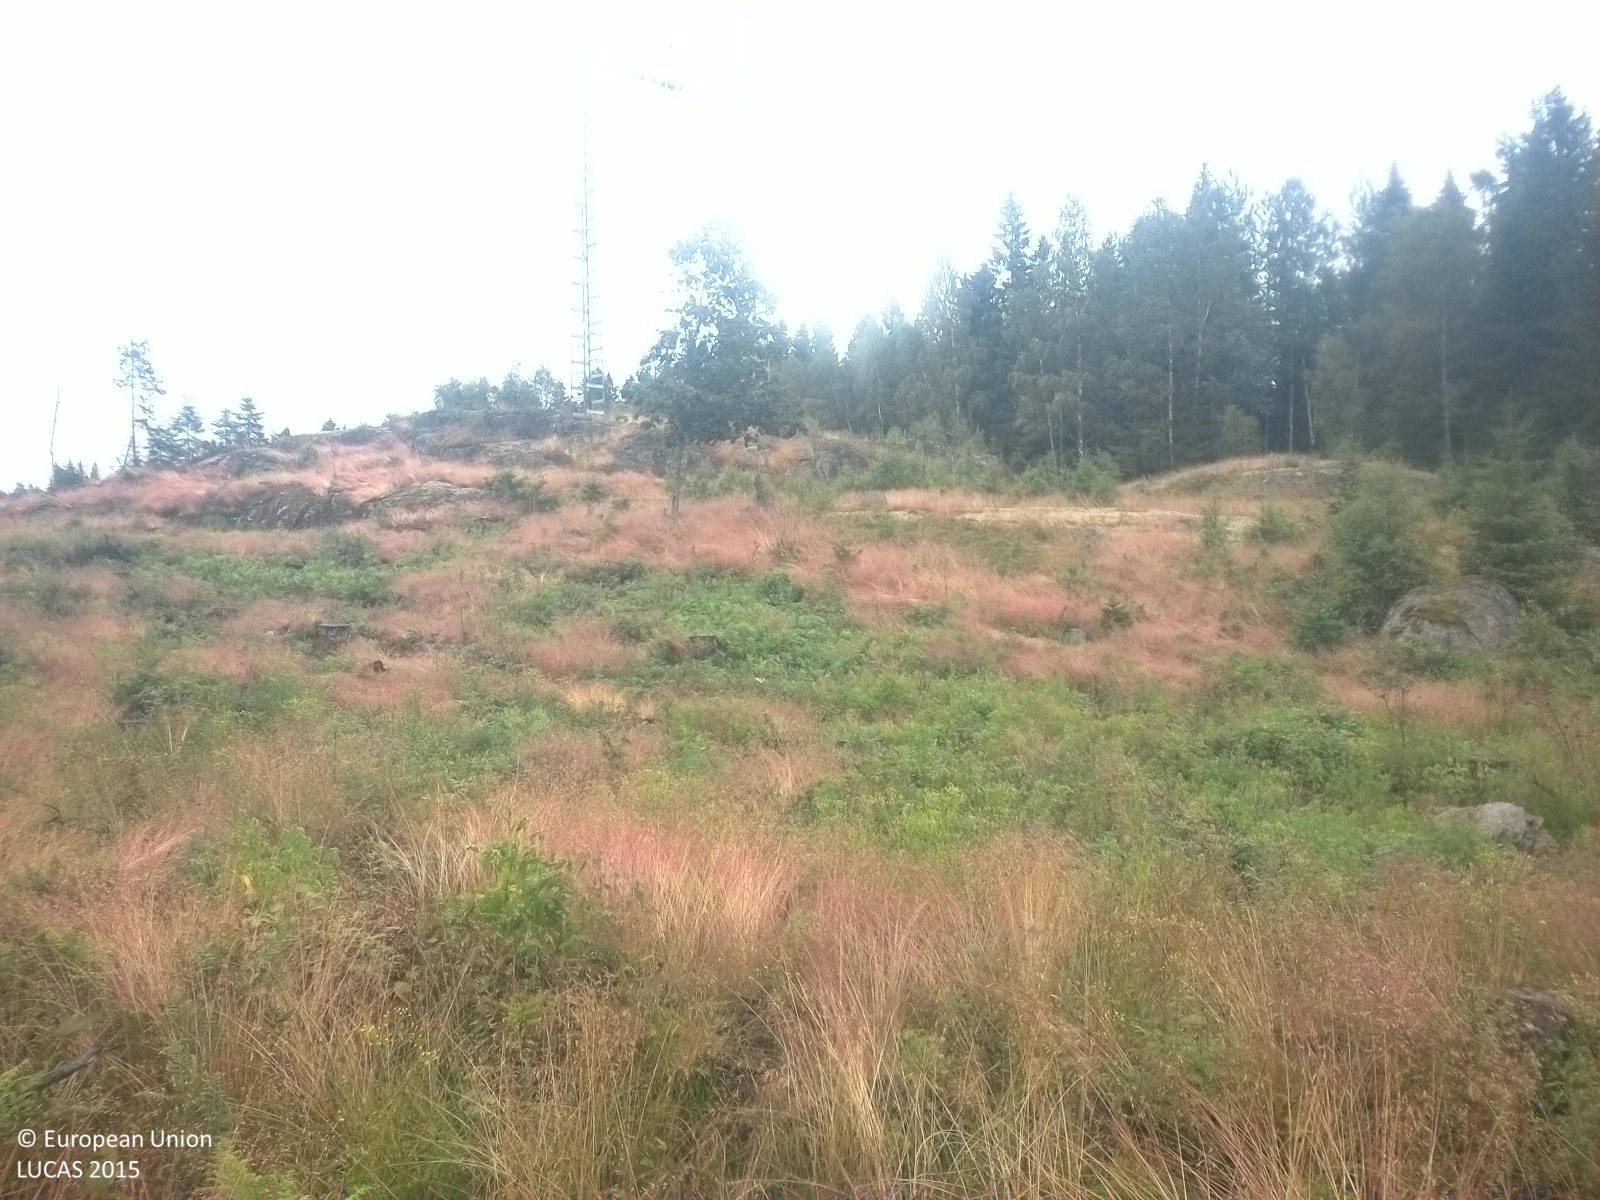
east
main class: Woodland
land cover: Spruce dominated coniferous woodland
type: boreal forest
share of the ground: 10 - 25 %
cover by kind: herbaceous plants 60 %, coniferous forest trees 20 %, shrubs 20 %
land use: Forestry
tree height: < 5 m
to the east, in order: Spruce dominated coniferous woodland; Spruce dominated mixed woodland; Broadleaved woodland; Electric lines; Grassland with sparse tree/shrub cover; Spruce dominated mixed woodland; Rivers and streams; Spruce dominated coniferous woodland
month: July
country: SE
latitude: 58.9973
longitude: 14.8486
